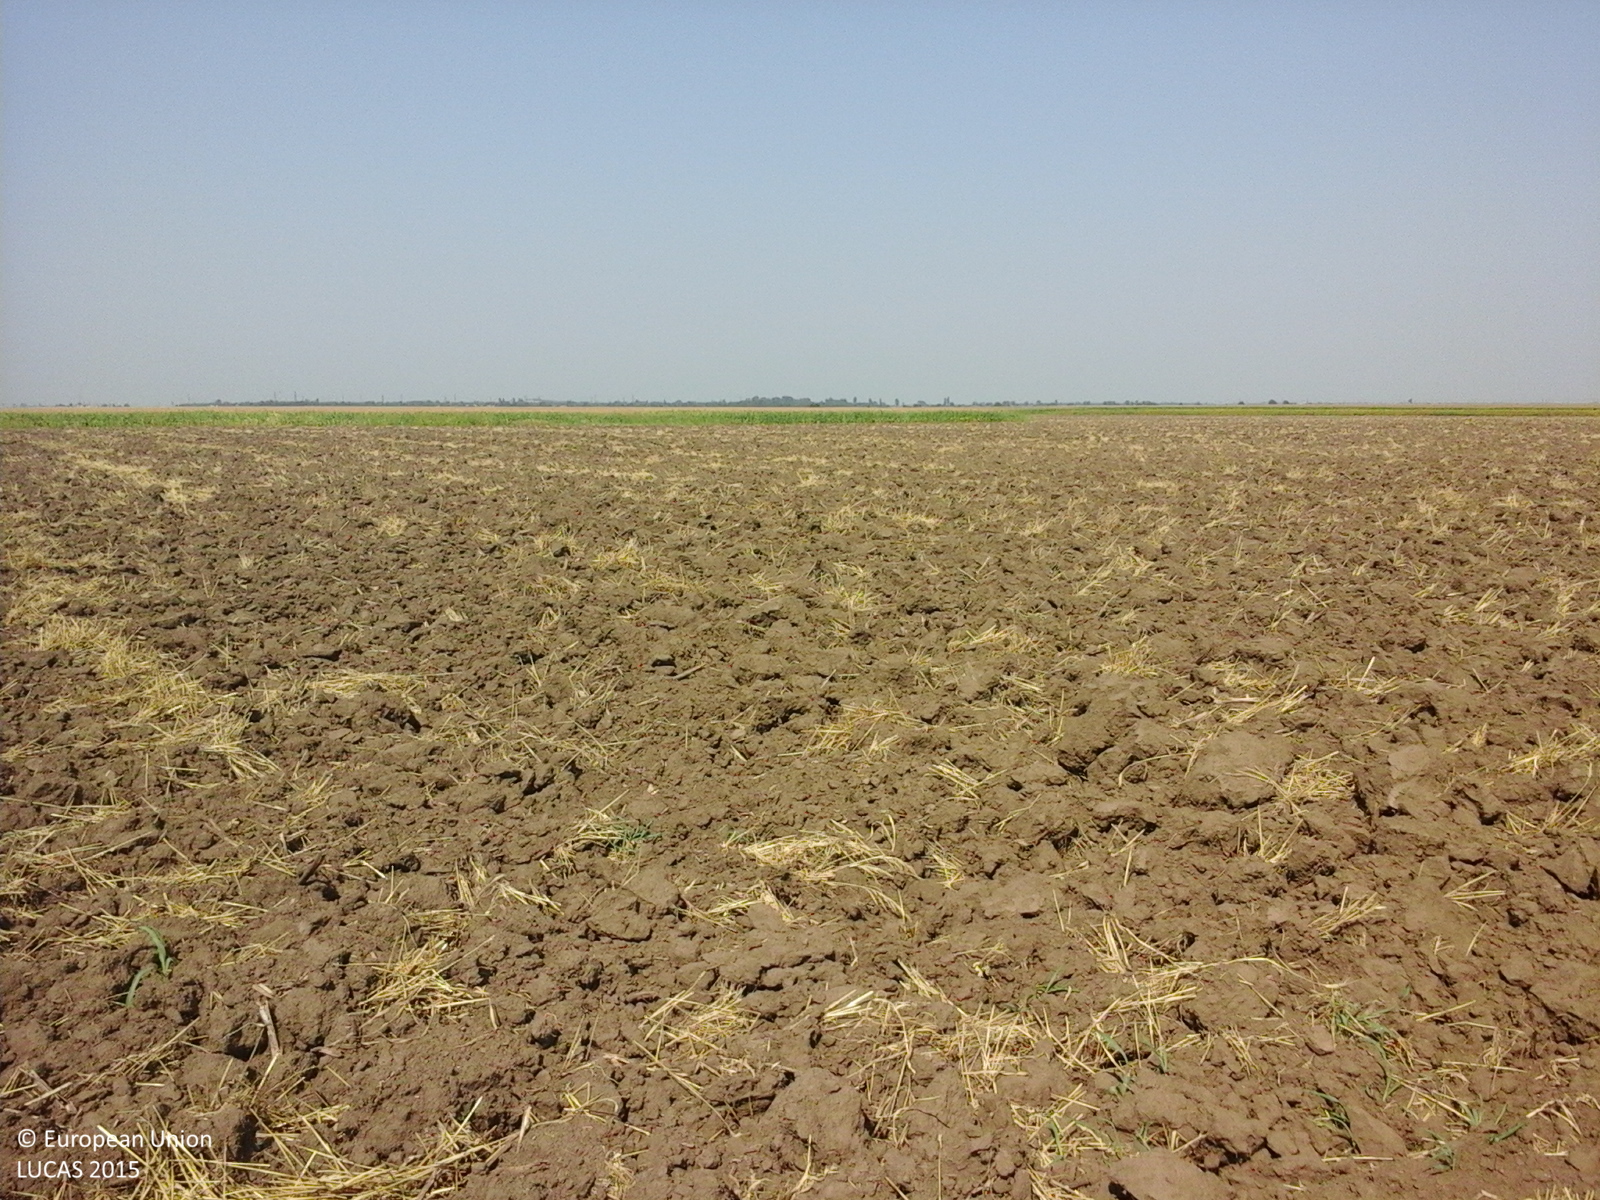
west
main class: Cropland
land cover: Common wheat
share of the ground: < 10 %
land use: Agriculture (excluding fallow land and kitchen gardens)
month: August
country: RO
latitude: 45.0834
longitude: 27.3595
